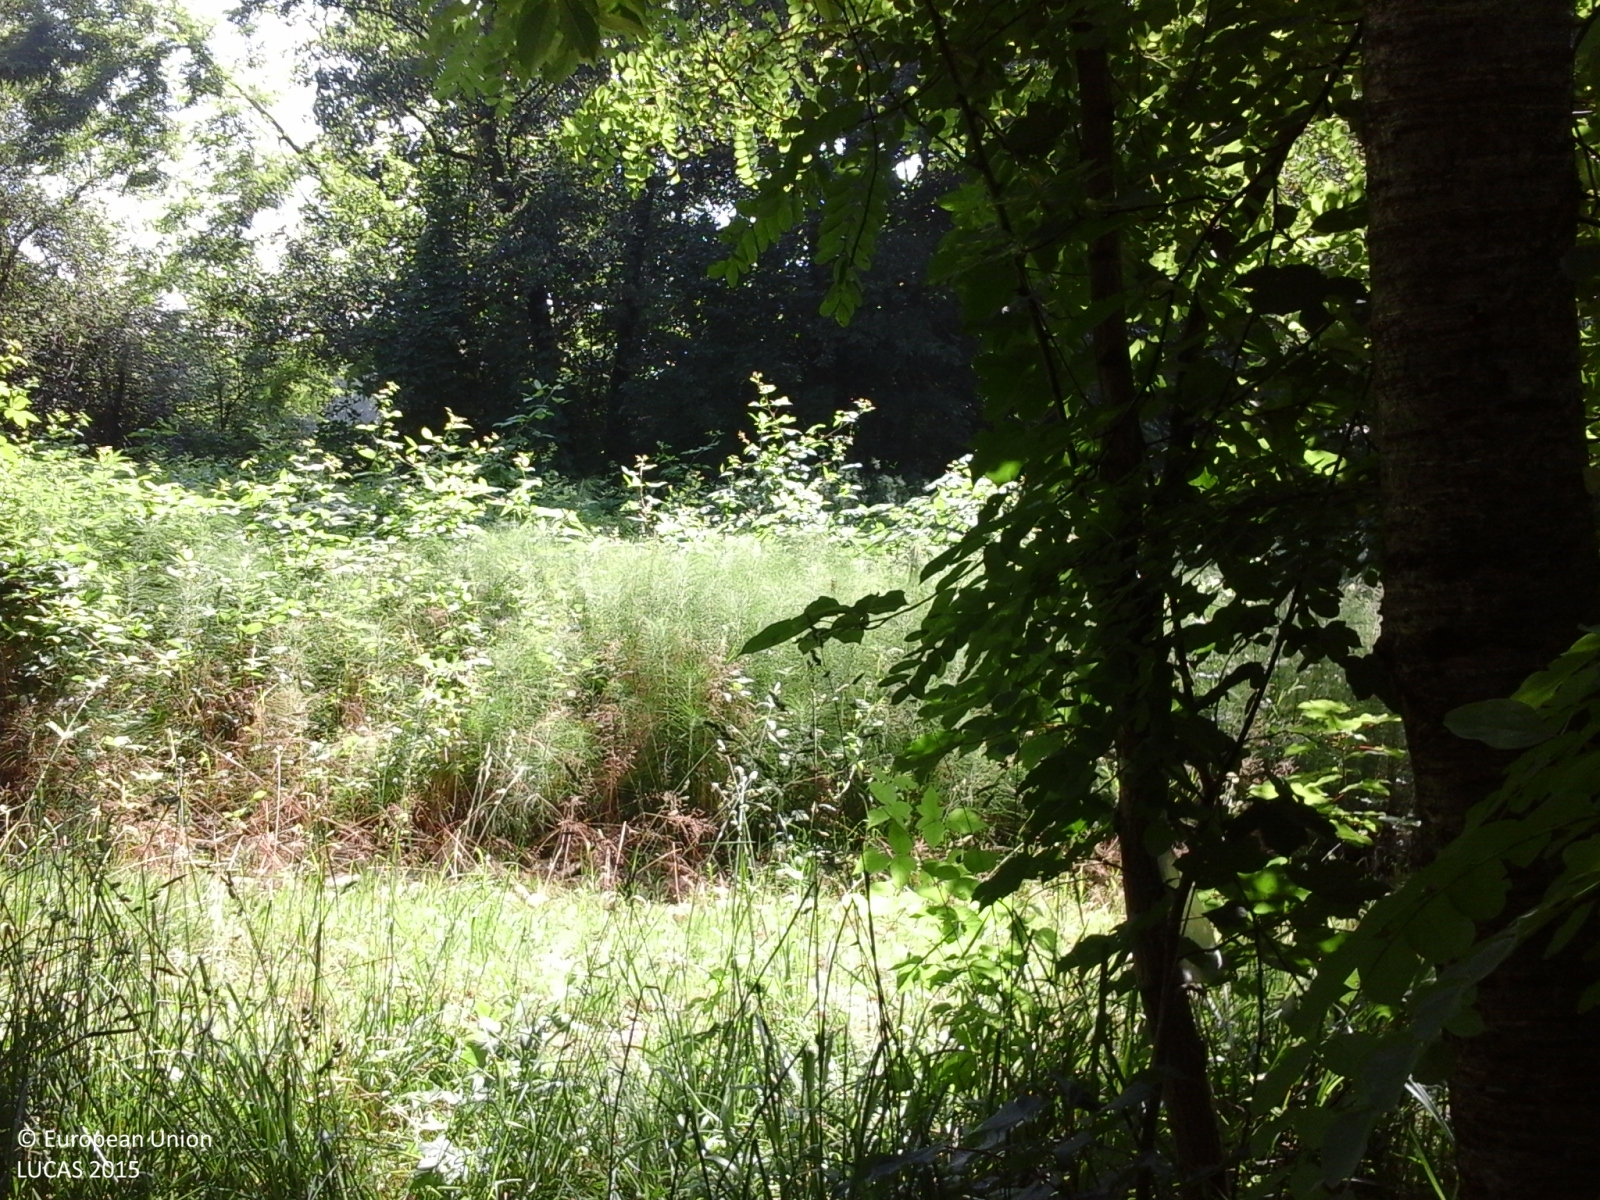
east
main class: Woodland
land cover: Broadleaved woodland
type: thermophilous deciduous forest
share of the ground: > 75 %
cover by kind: broadleaved forest trees 85 %, herbaceous plants 10 %, shrubs 5 %
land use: Forestry
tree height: > 5 m
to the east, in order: Broadleaved woodland; Tracks; Broadleaved woodland
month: June
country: IT
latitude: 44.4154
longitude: 7.7066
